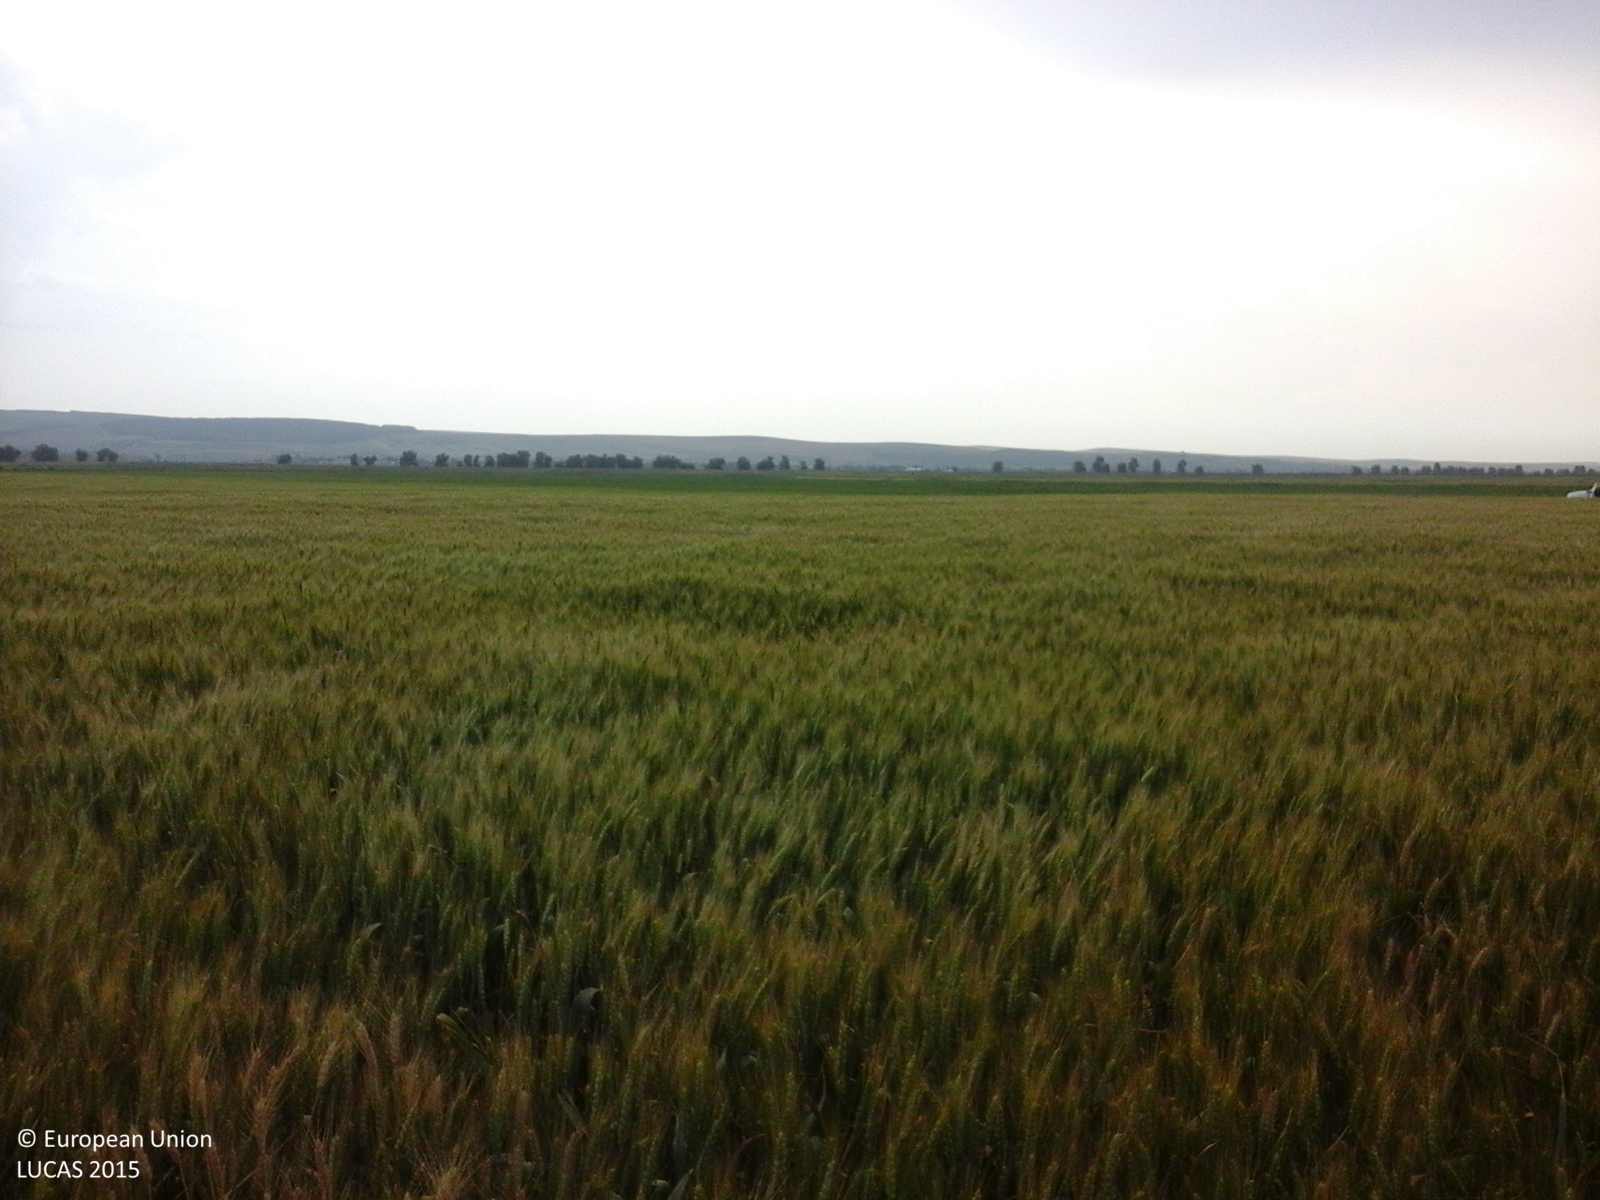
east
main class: Cropland
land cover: Common wheat
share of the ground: > 75 %
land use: Agriculture (excluding fallow land and kitchen gardens)
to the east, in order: Common wheat; Tracks; Soya
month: June
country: RO
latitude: 47.2887
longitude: 26.6868
